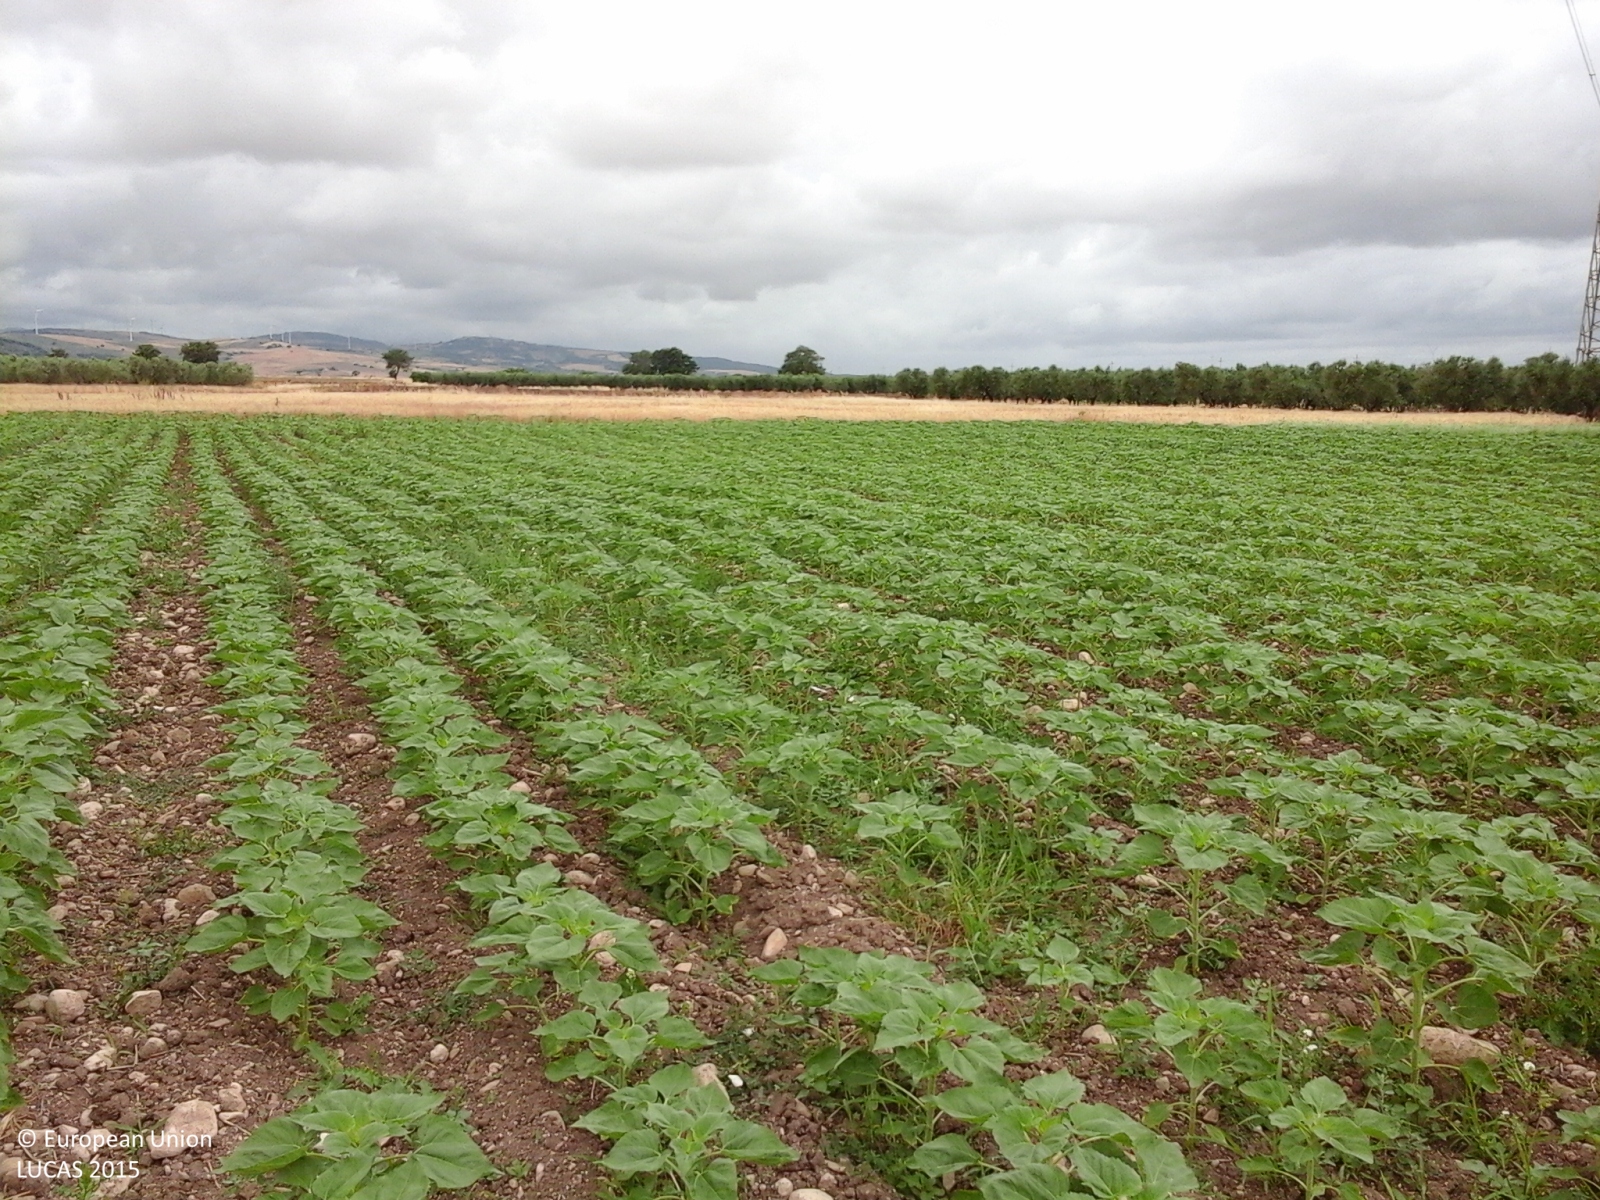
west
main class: Artificial land
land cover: Other artificial areas
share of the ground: > 75 %
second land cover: Sunflower
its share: > 75 %
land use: Electricity, gas and thermal power distribution
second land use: Agriculture (excluding fallow land and kitchen gardens)
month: June
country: IT
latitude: 41.7680
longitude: 15.0481
